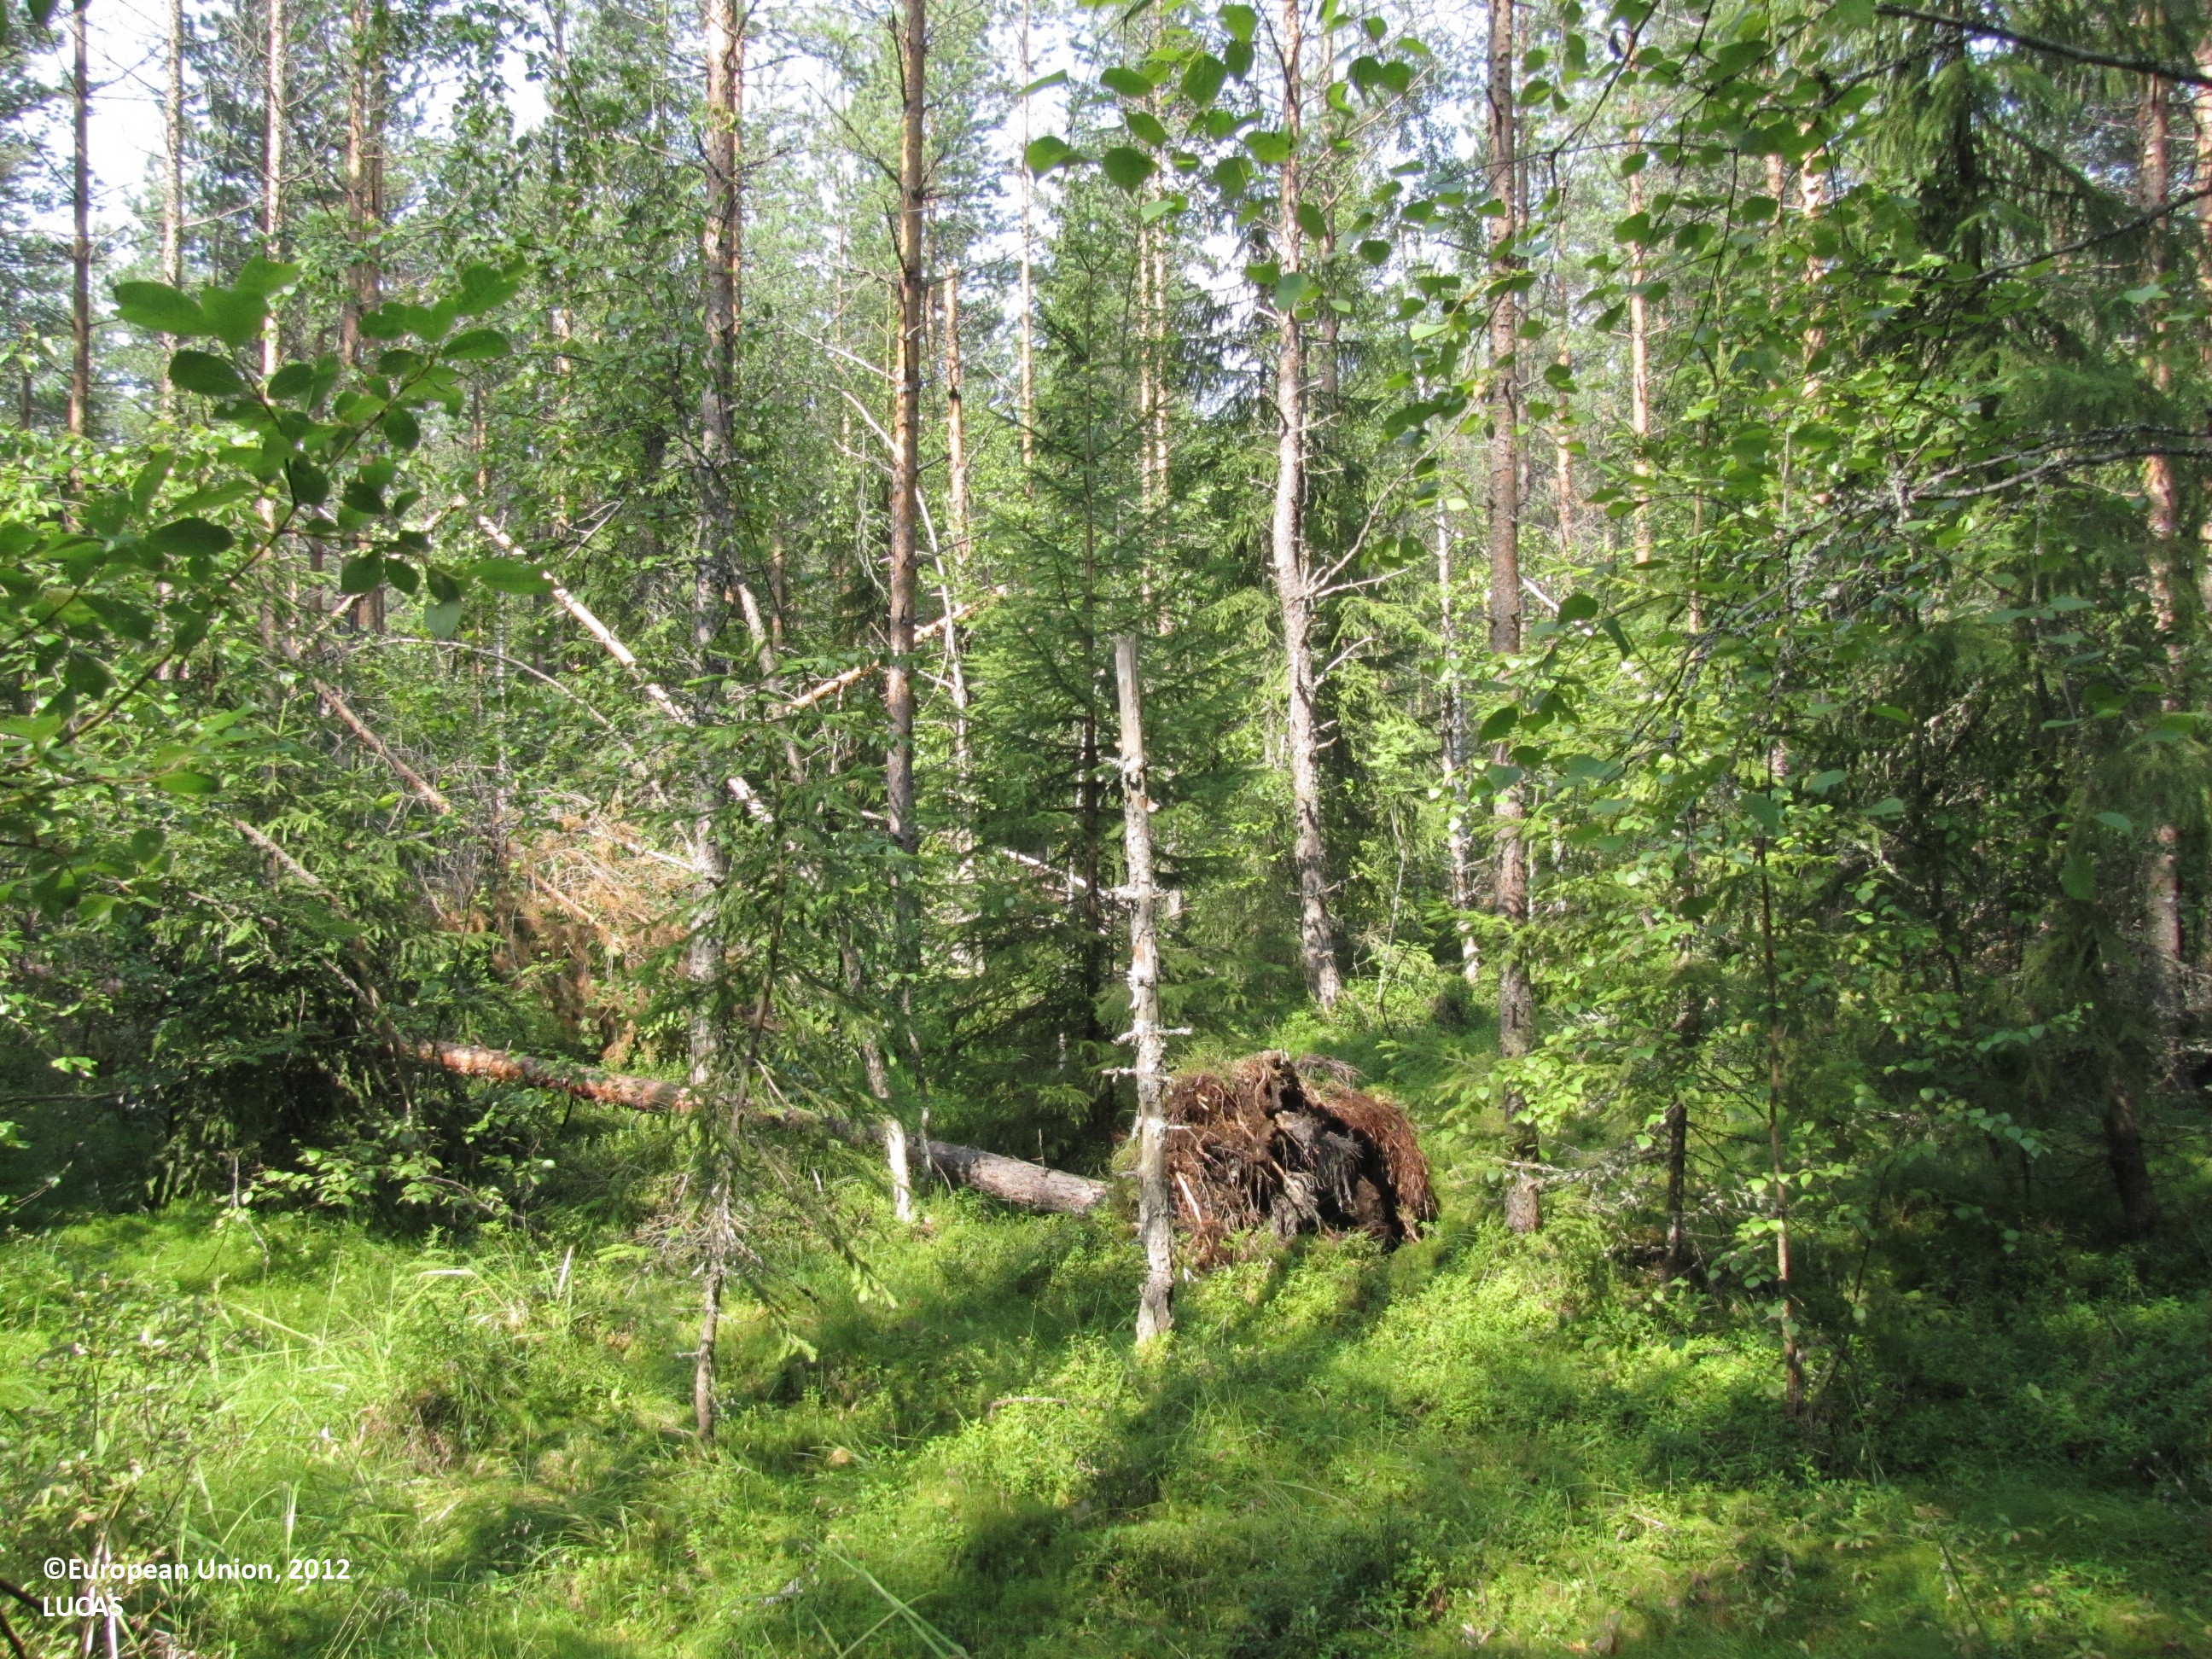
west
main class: Woodland
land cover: Other coniferous woodland
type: boreal forest
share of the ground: 50 - 75 %
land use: Forestry
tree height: > 5 m
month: July
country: FI
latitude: 62.0037
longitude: 23.2668
